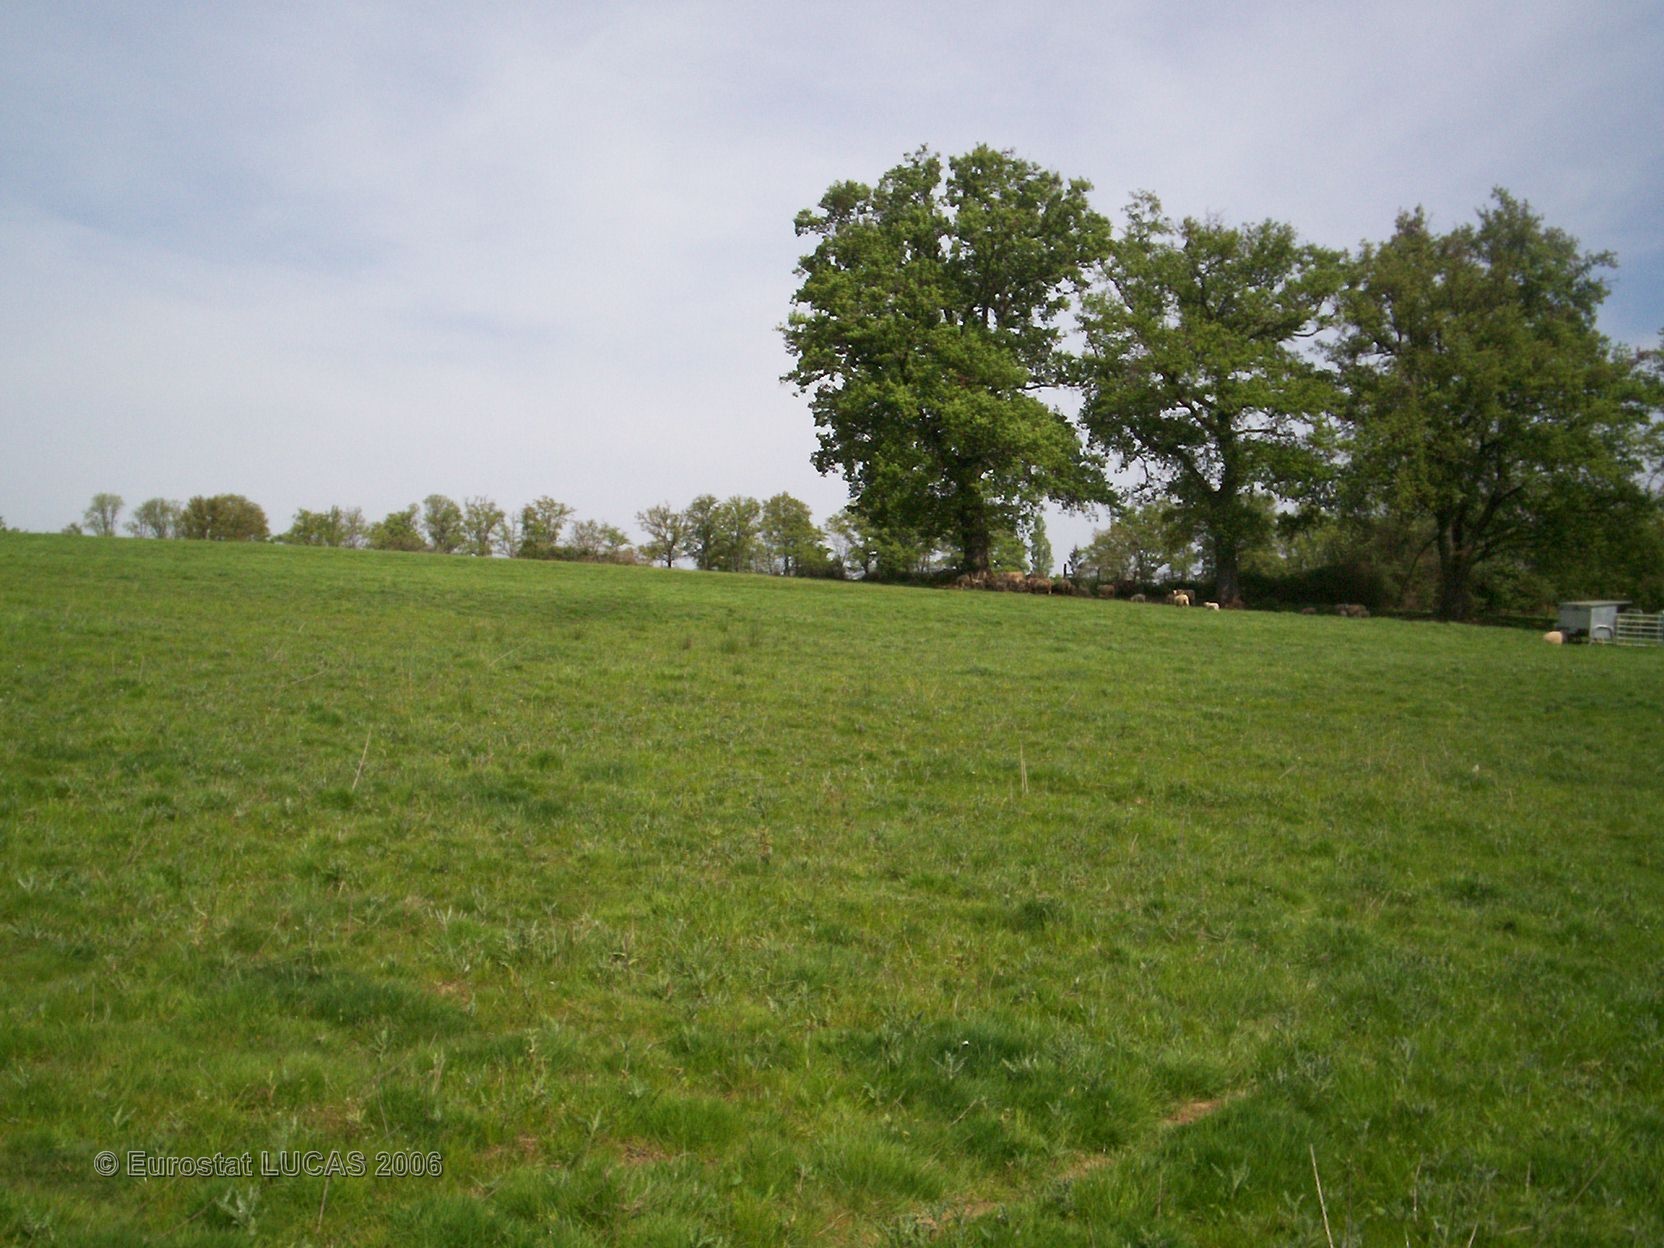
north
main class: Grassland
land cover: Grassland without tree/shrub cover
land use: Agriculture (excluding fallow land and kitchen gardens)
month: May
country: FR
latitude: 45.9976
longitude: 0.6766
